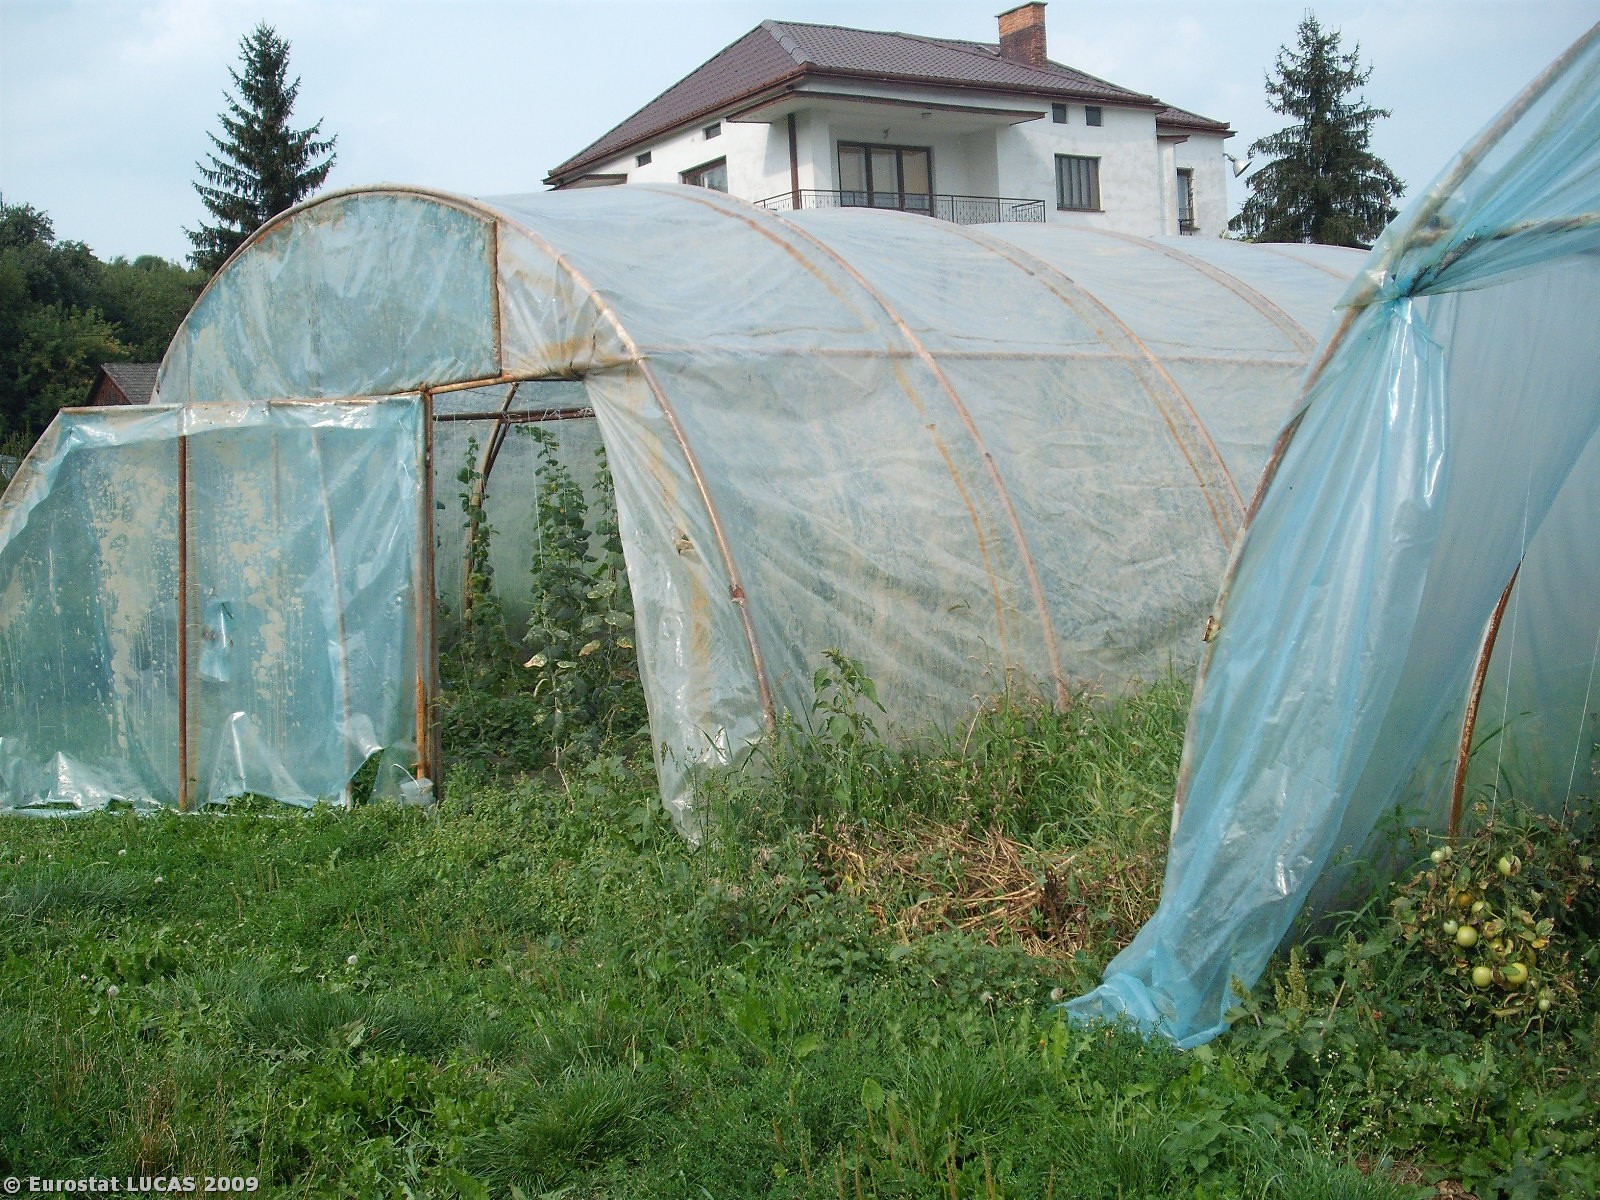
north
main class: Grassland
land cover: Grassland without tree/shrub cover
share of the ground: > 75 %
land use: Agriculture (excluding fallow land and kitchen gardens)
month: August
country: PL
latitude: 50.7676
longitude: 21.8096
